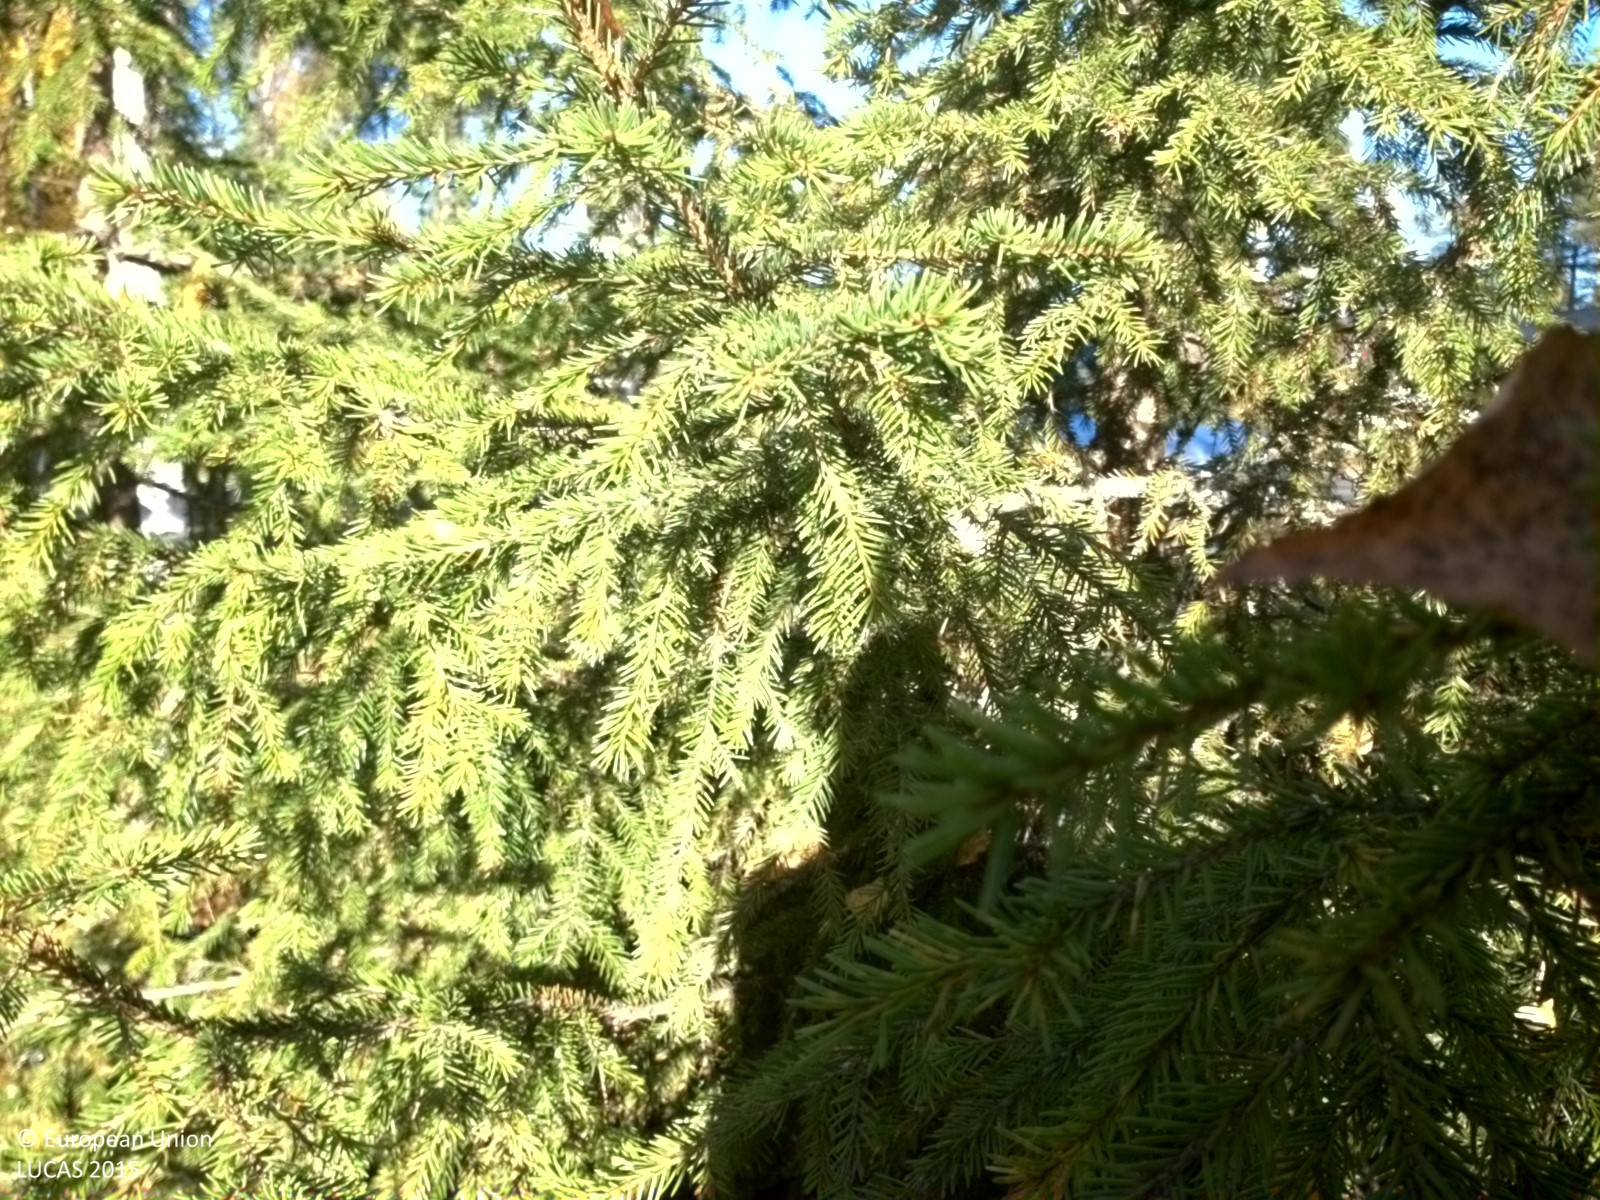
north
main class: Woodland
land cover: Spruce dominated mixed woodland
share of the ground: 50 - 75 %
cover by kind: coniferous forest trees 40 %, shrubs 30 %, broadleaved forest trees 20 %, herbaceous plants 10 %
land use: Residential
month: October
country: SE
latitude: 65.7620
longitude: 21.3876
